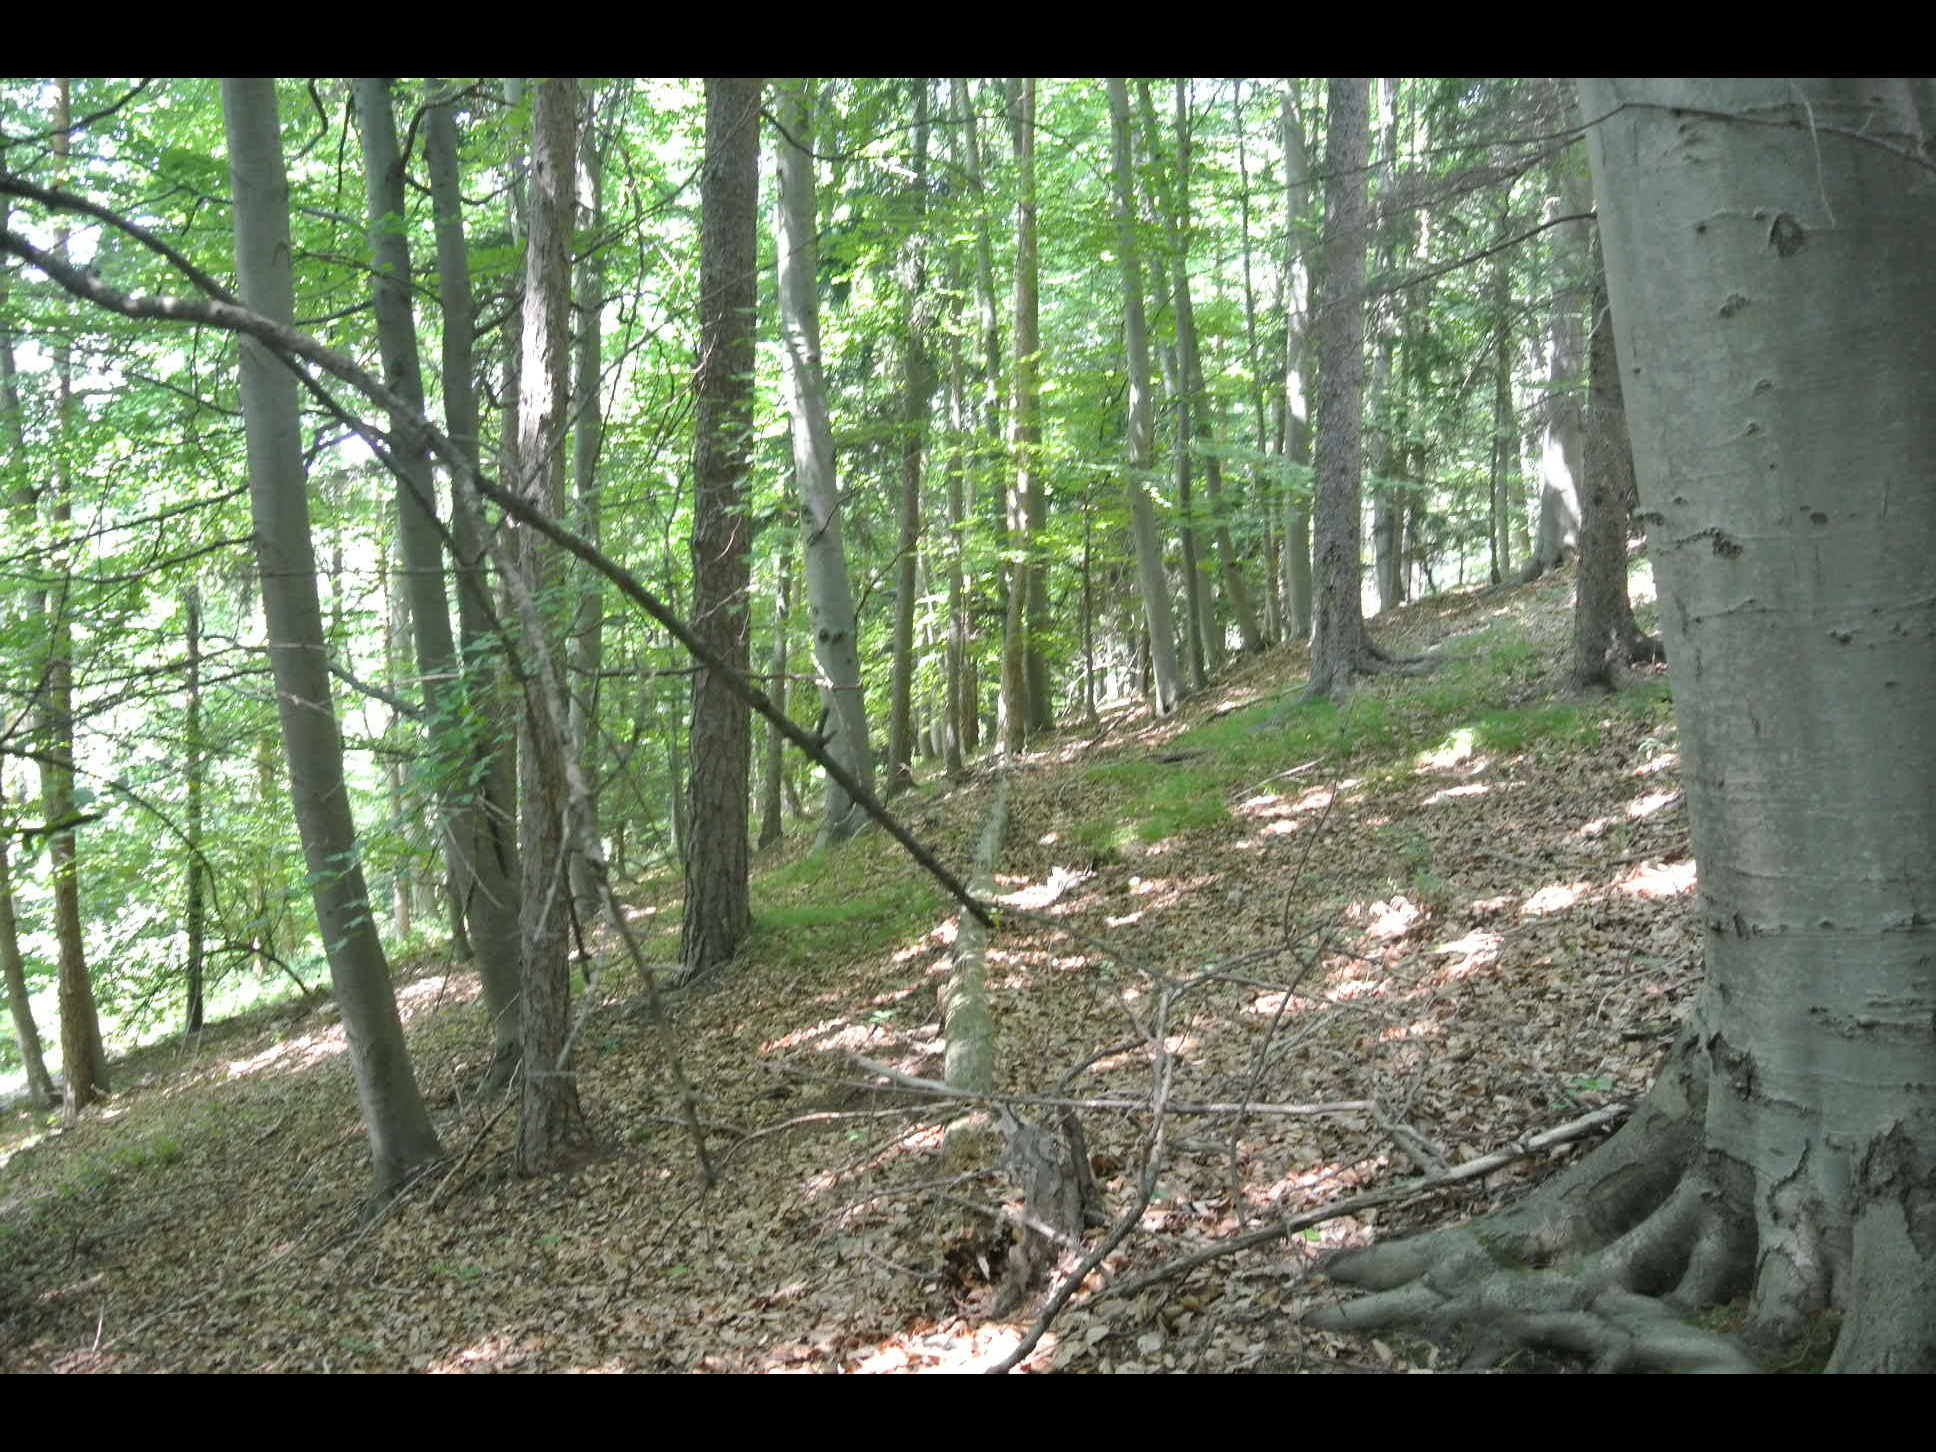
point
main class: Woodland
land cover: Spruce dominated mixed woodland
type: alpine coniferous forest
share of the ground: > 75 %
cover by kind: broadleaved forest trees 60 %, coniferous forest trees 40 %
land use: Forestry
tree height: > 5 m
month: July
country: AT
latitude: 47.6538
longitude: 16.1675
